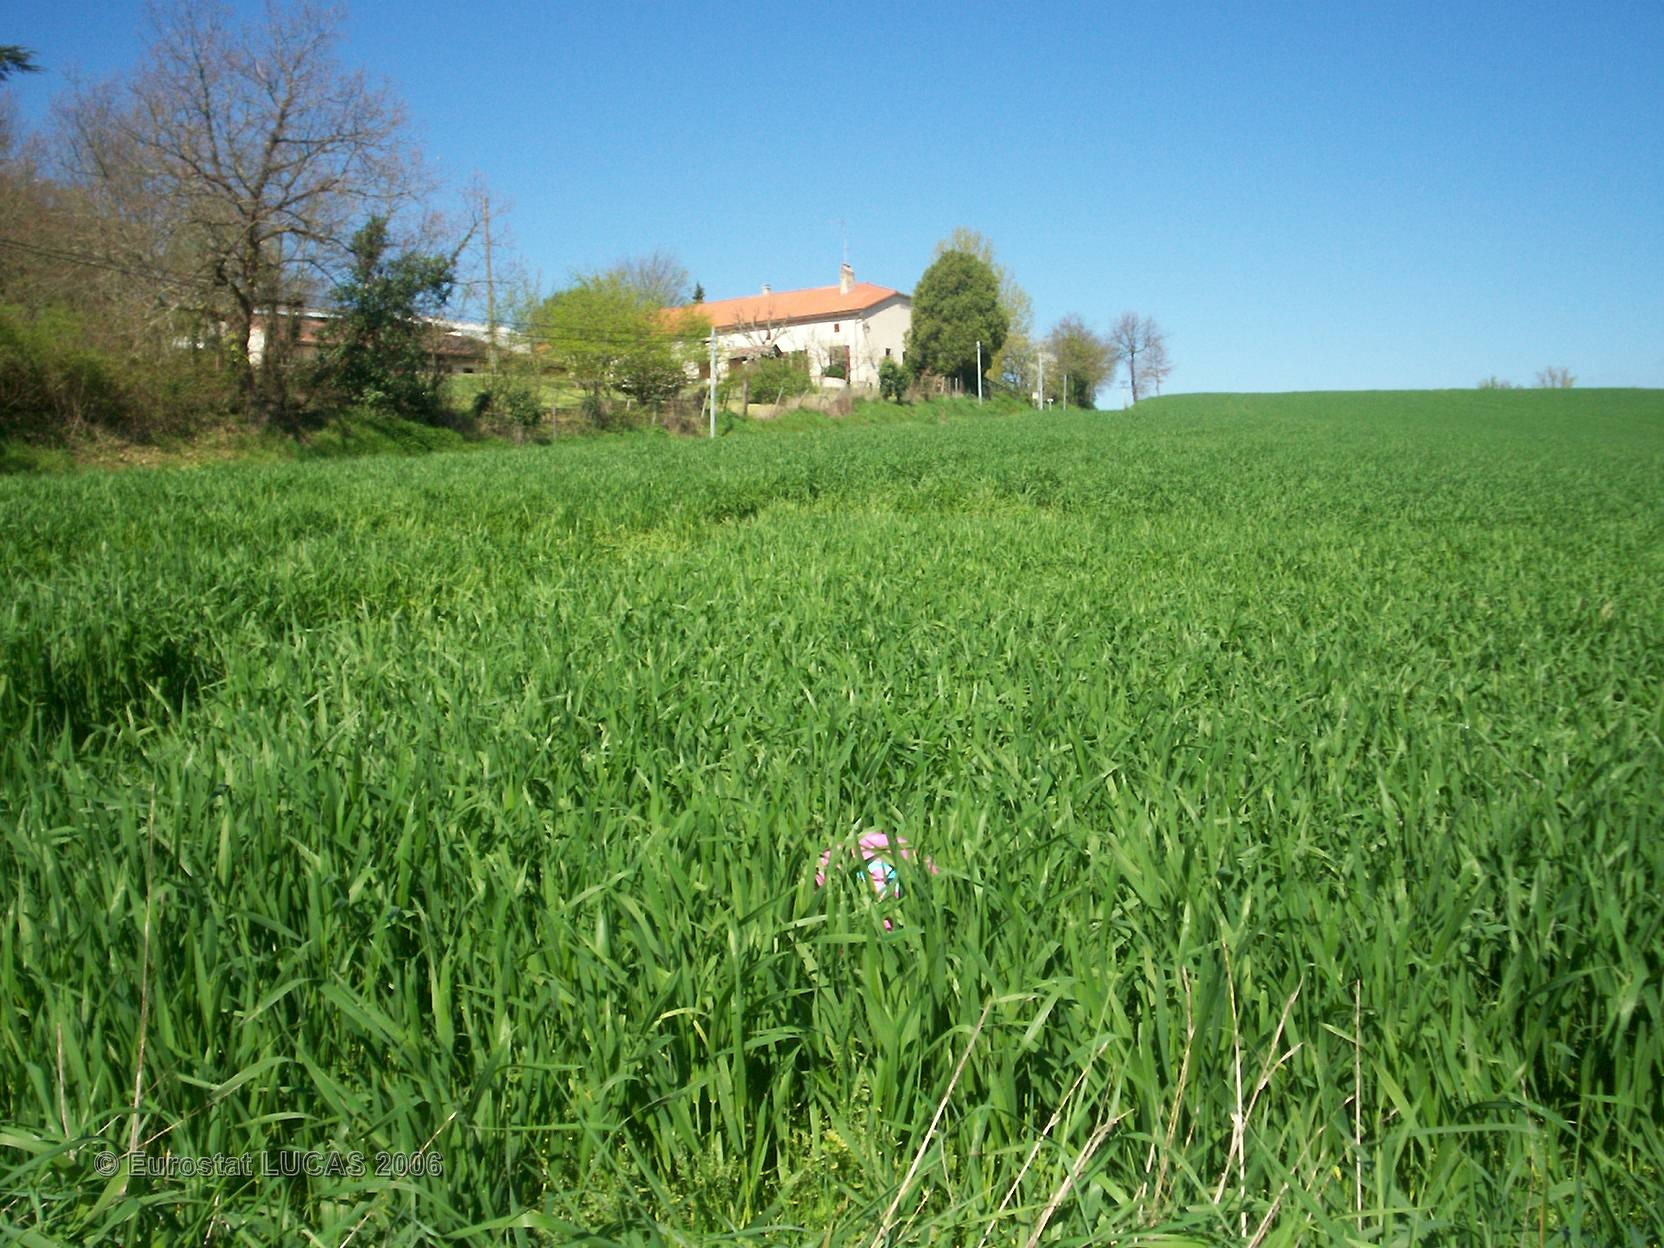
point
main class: Cropland
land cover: Common wheat
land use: Agriculture (excluding fallow land and kitchen gardens)
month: April
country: FR
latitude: 44.0677
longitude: 0.7950
